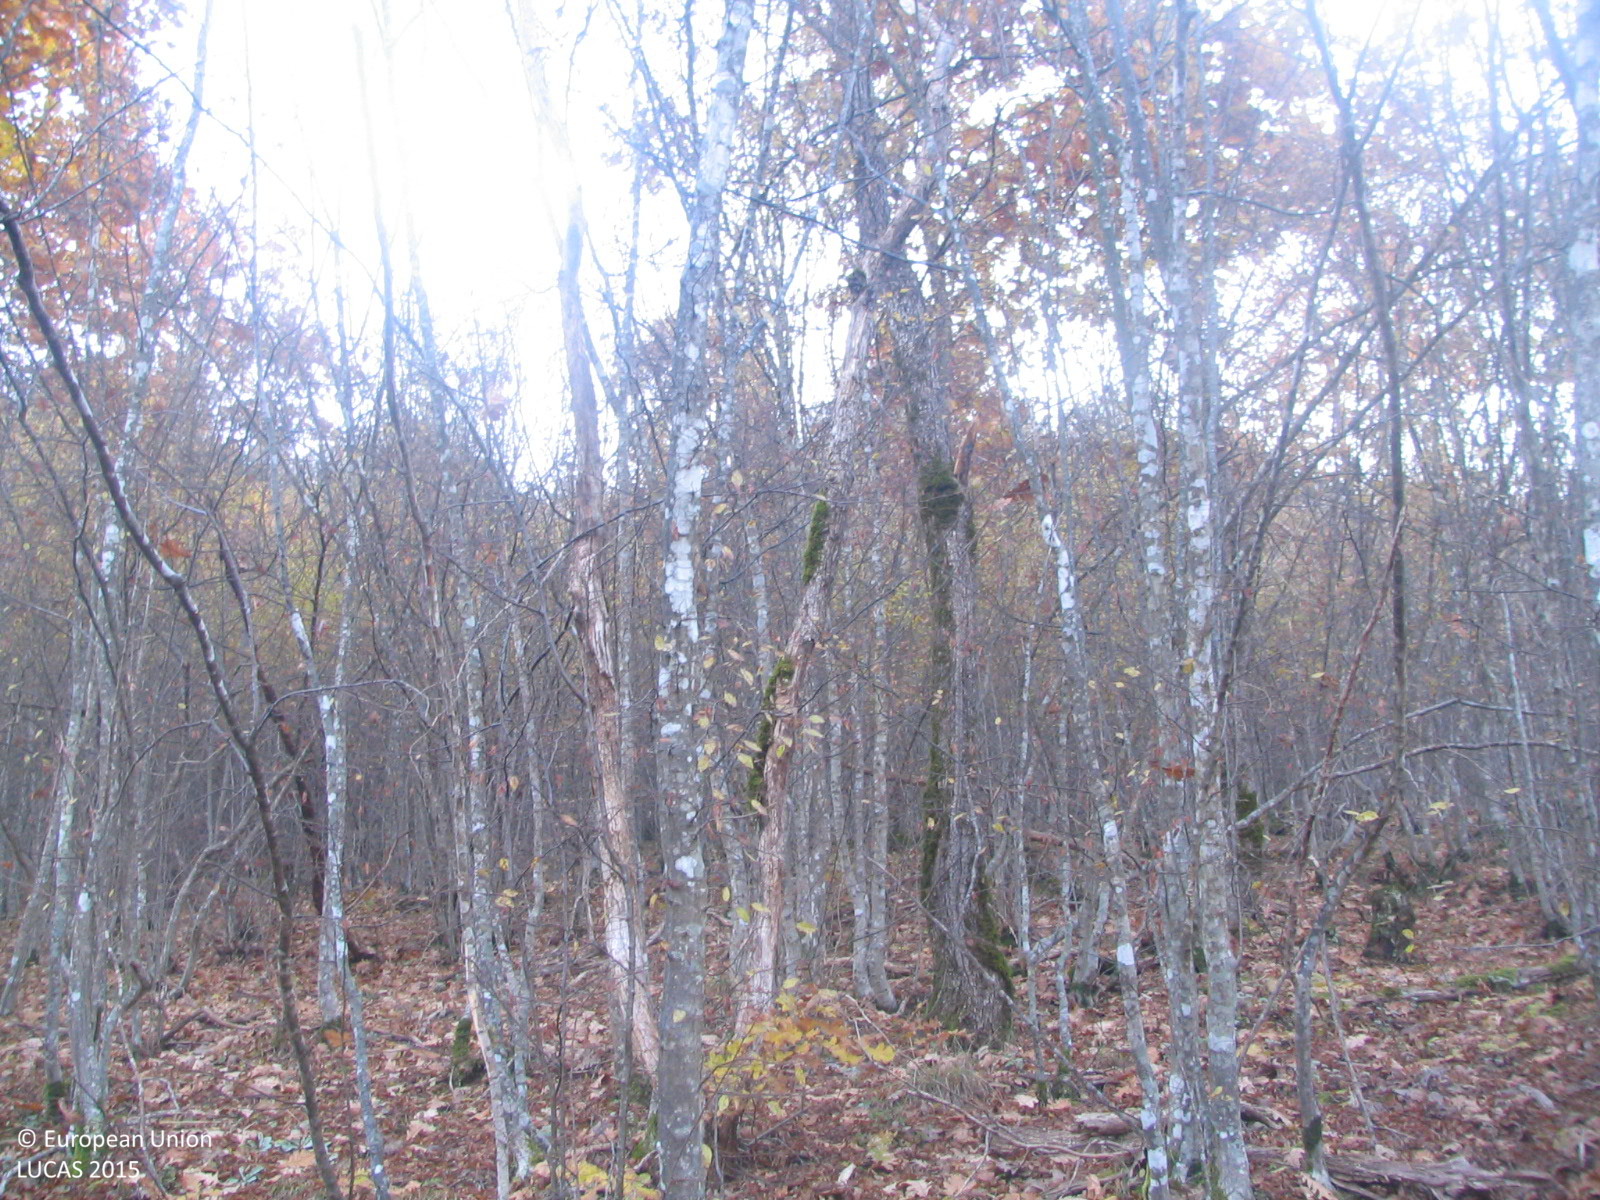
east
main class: Woodland
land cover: Broadleaved woodland
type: acidophilous oak and oak-birch forest
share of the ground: > 75 %
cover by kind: broadleaved forest trees 90 %, shrubs 5 %, herbaceous plants 5 %
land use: Forestry
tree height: > 5 m
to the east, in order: Broadleaved woodland; Tracks; Broadleaved woodland
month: November
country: BG
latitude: 42.9923
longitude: 23.7438
